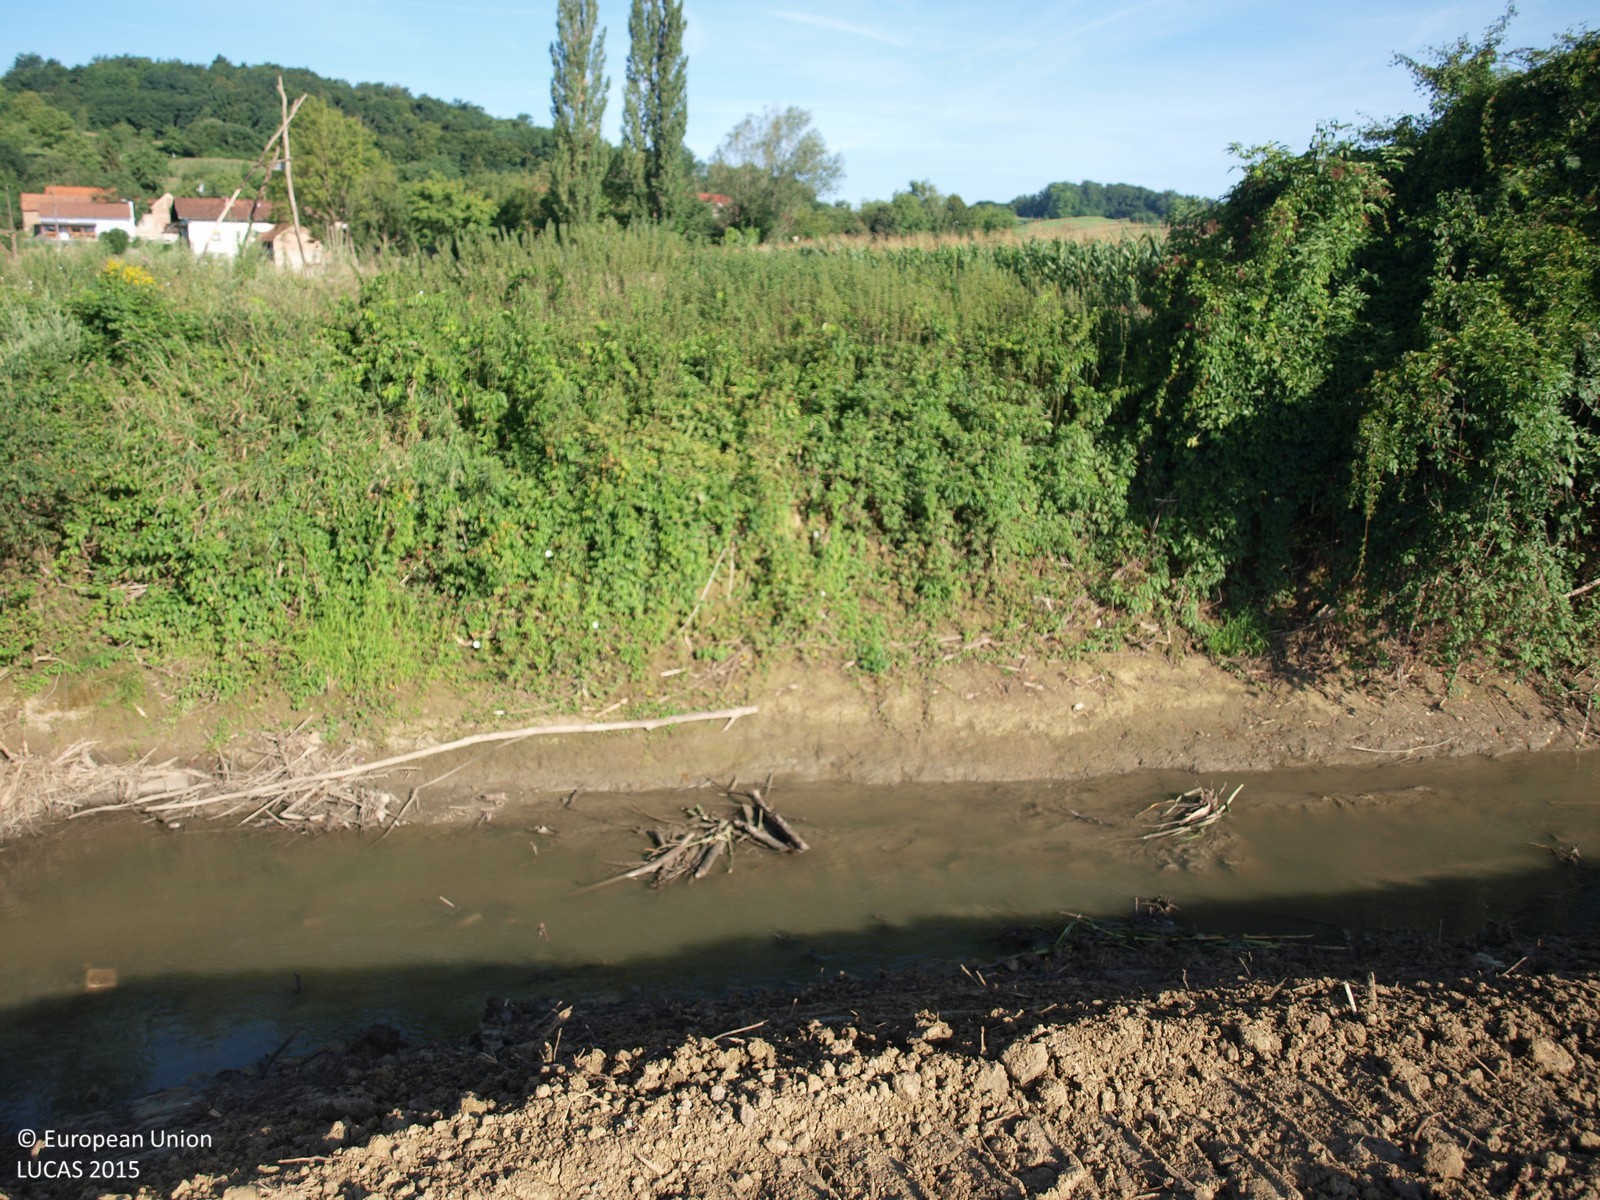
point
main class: Shrubland
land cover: Shrubland with sparse tree cover
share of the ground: > 75 %
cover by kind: shrubs 95 %, broadleaved forest trees 5 %
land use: Semi-natural and natural areas not in use
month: August
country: HR
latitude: 46.0395
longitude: 16.2921
